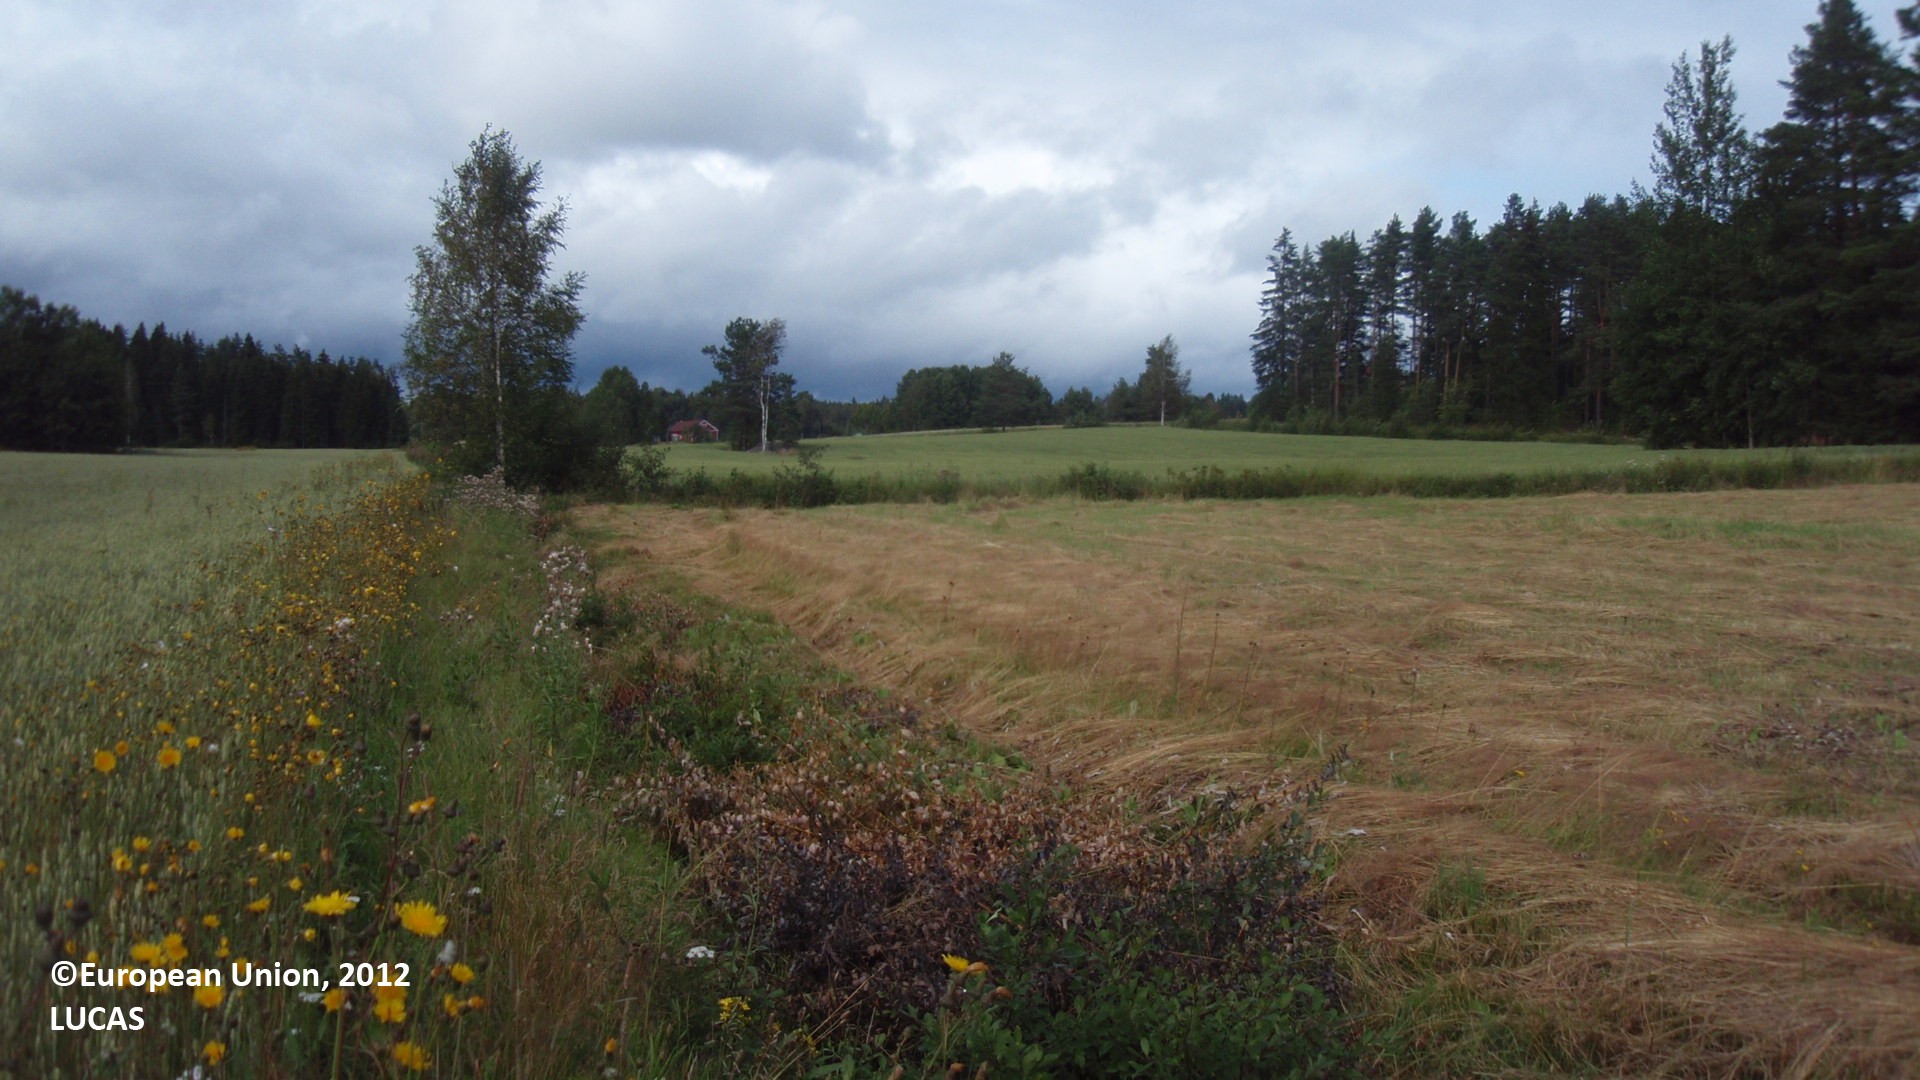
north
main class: Cropland
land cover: Common wheat
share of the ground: > 75 %
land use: Agriculture (excluding fallow land and kitchen gardens)
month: August
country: FI
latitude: 61.0766
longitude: 27.0151
